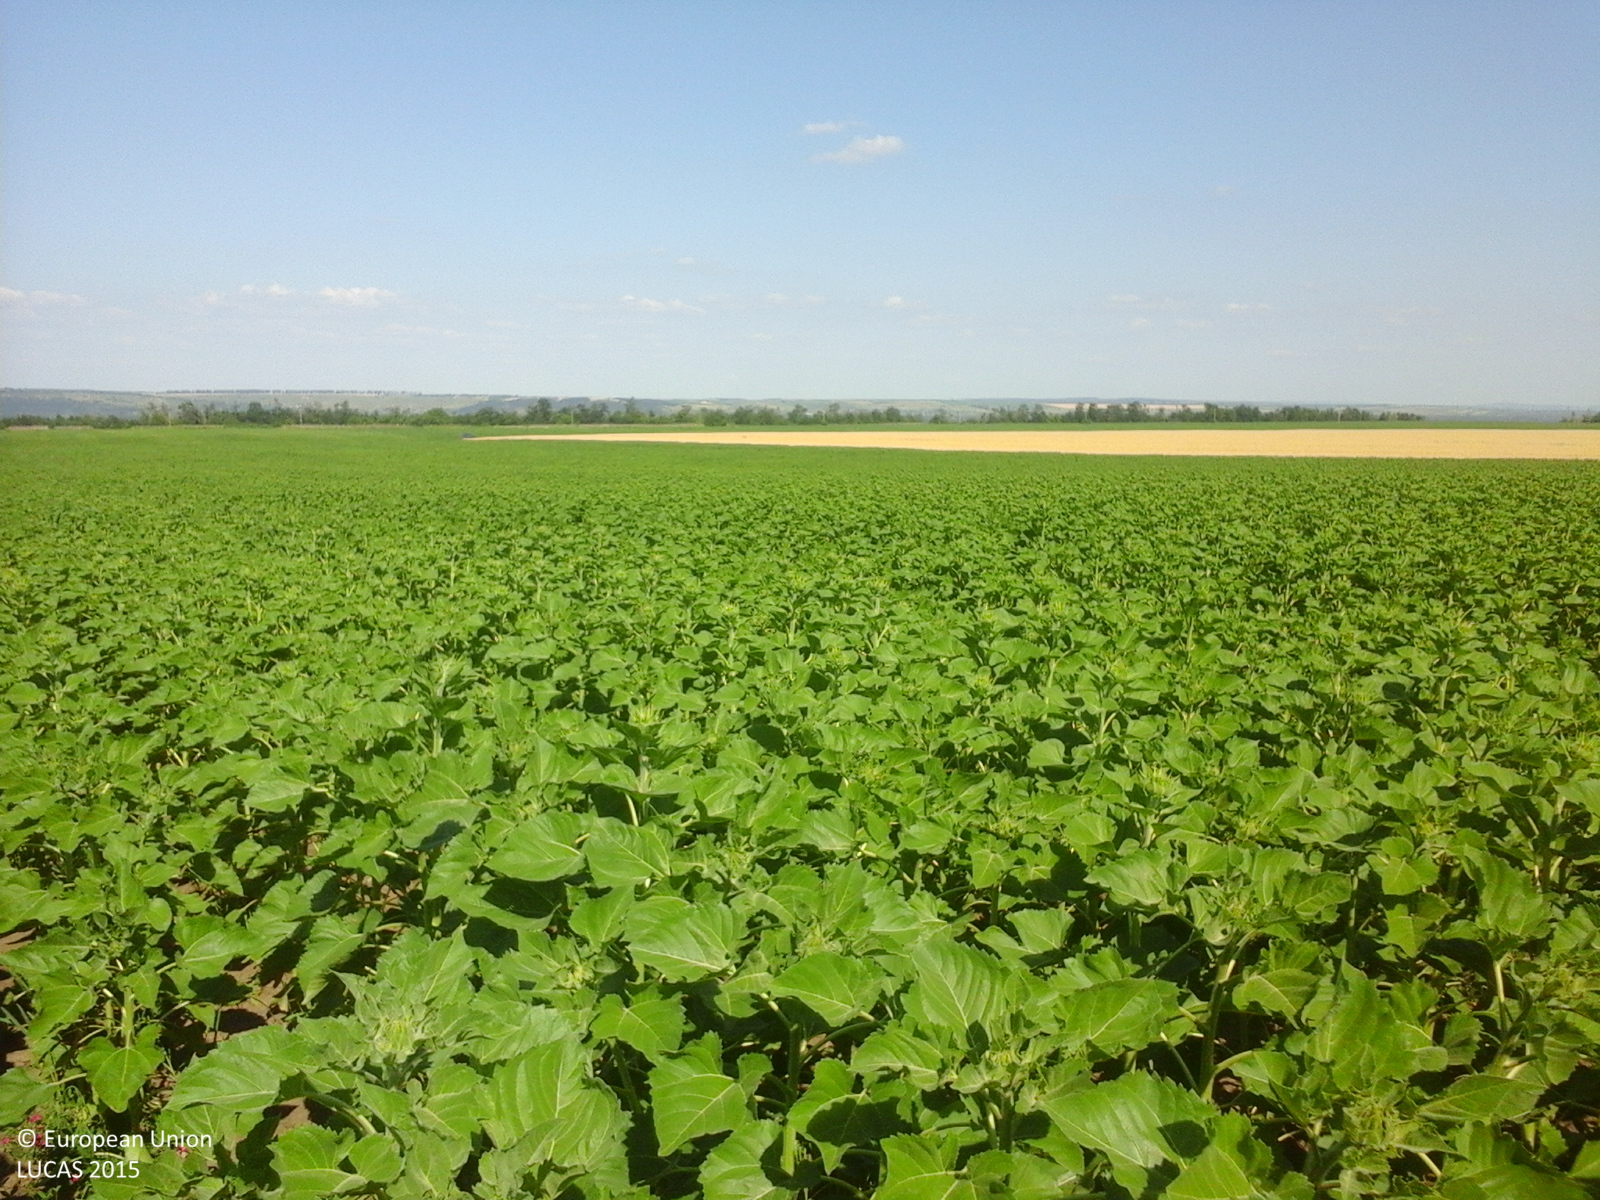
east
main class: Cropland
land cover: Sunflower
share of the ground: > 75 %
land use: Agriculture (excluding fallow land and kitchen gardens)
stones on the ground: < 10 %
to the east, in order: Sunflower
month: June
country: RO
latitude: 47.4000
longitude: 27.4881
